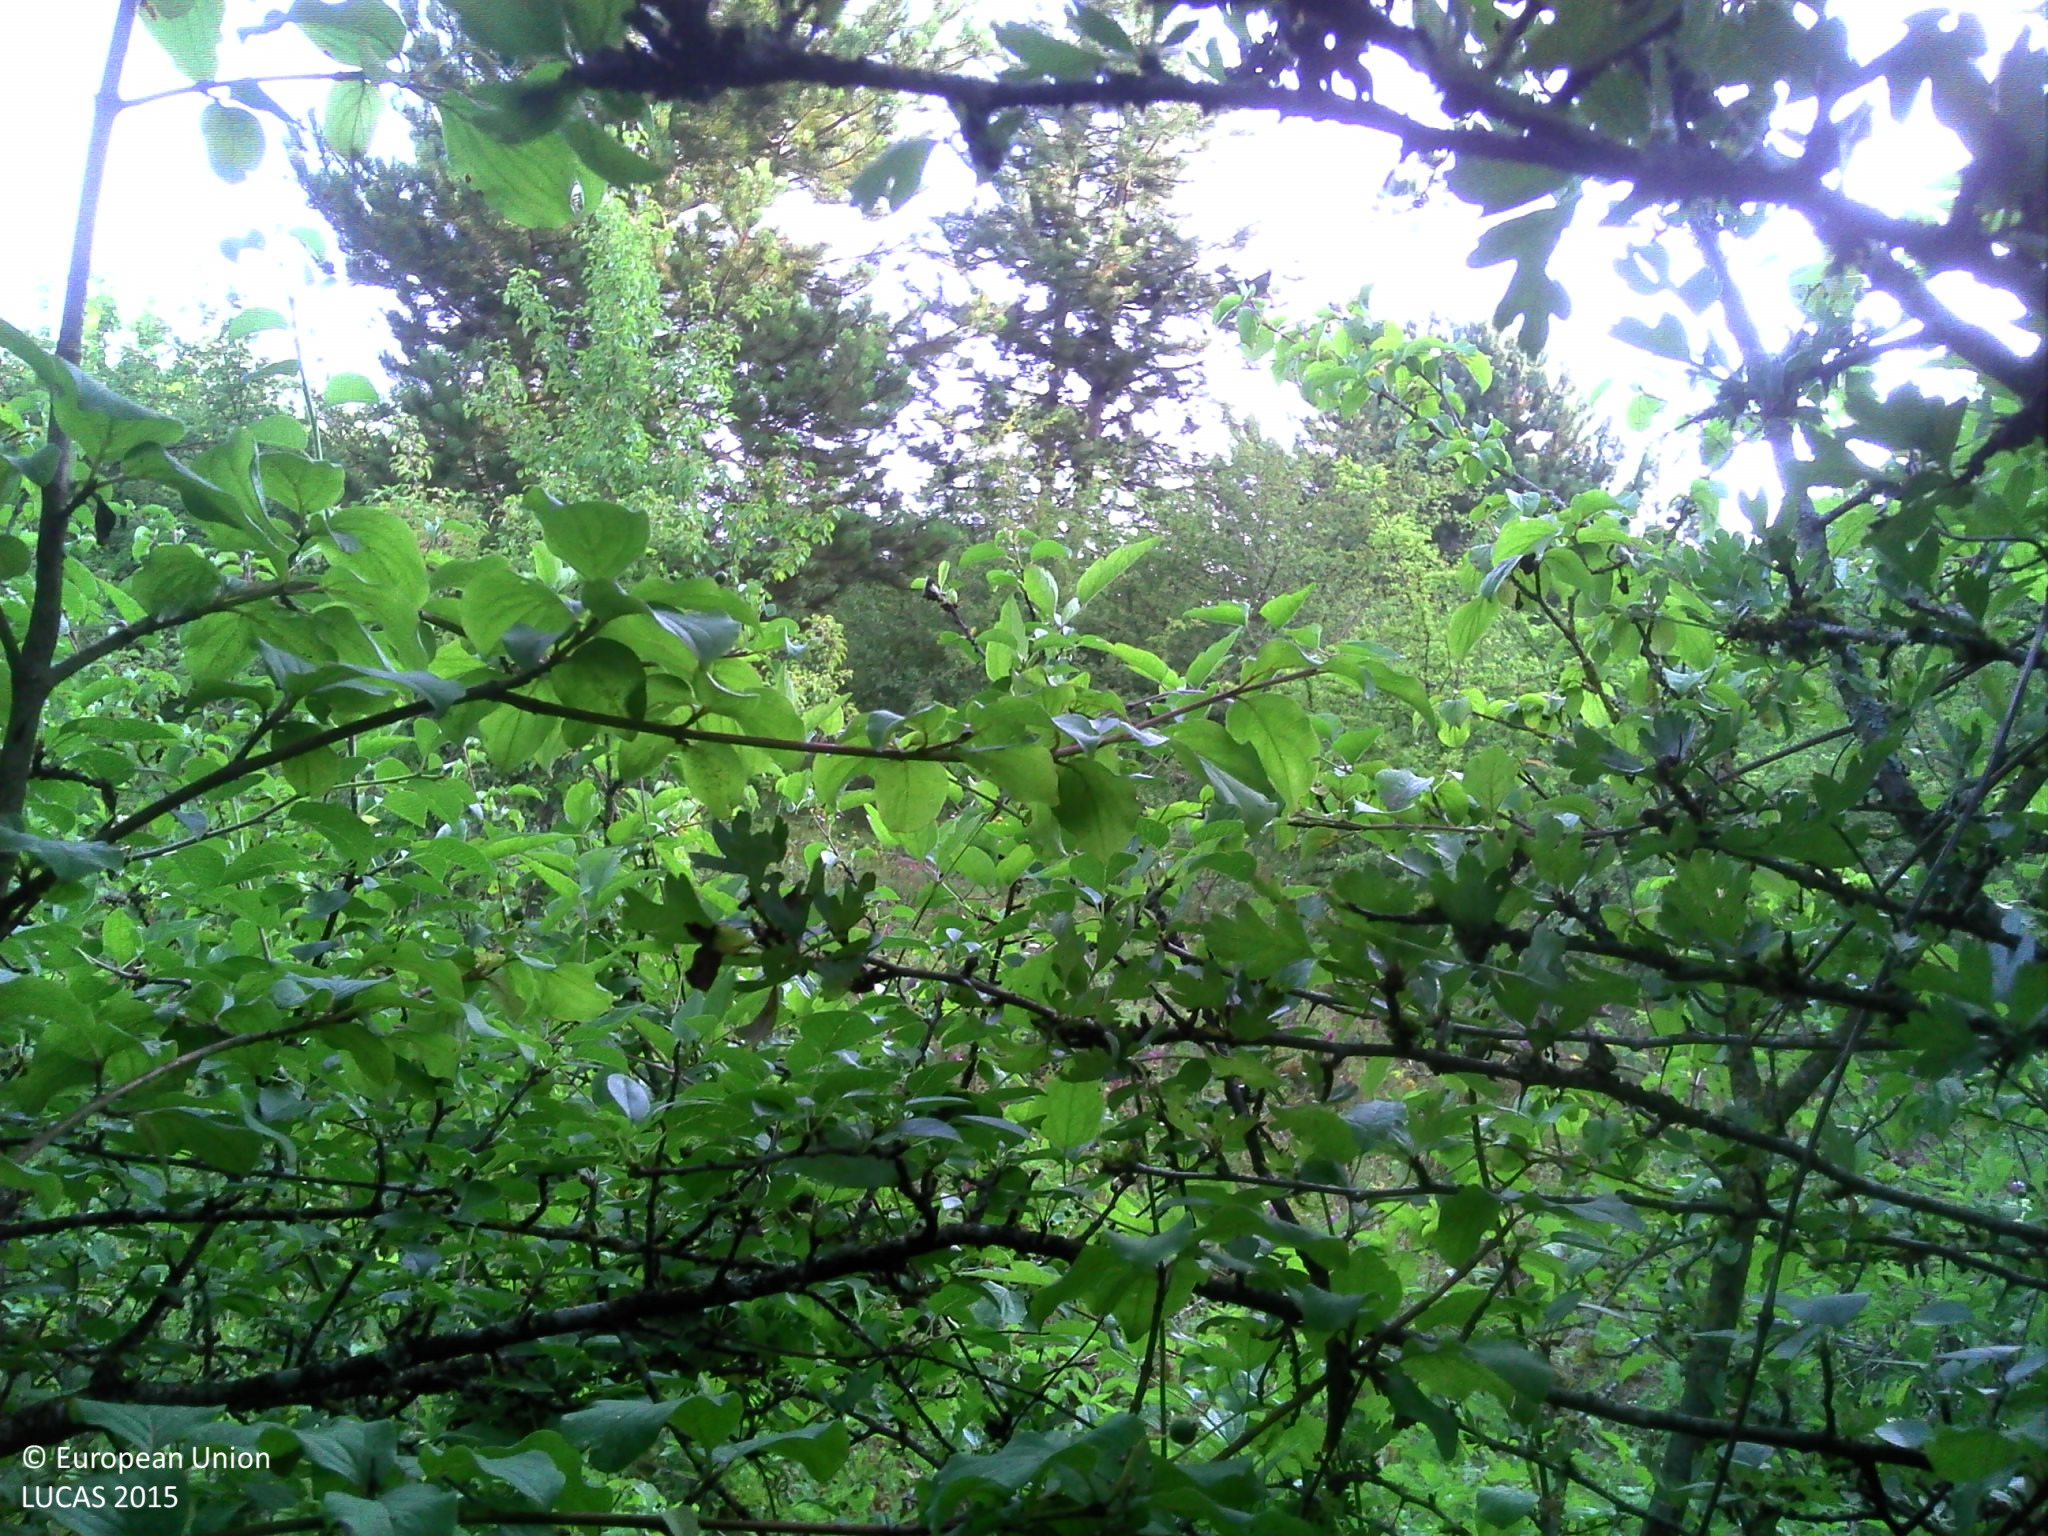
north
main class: Woodland
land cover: Pine dominated mixed woodland
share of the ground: > 75 %
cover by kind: broadleaved forest trees 60 %, coniferous forest trees 30 %, herbaceous plants 5 %, lichens and mosses 5 %
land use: Forestry
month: July
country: FR
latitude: 47.7460
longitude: 3.5538
